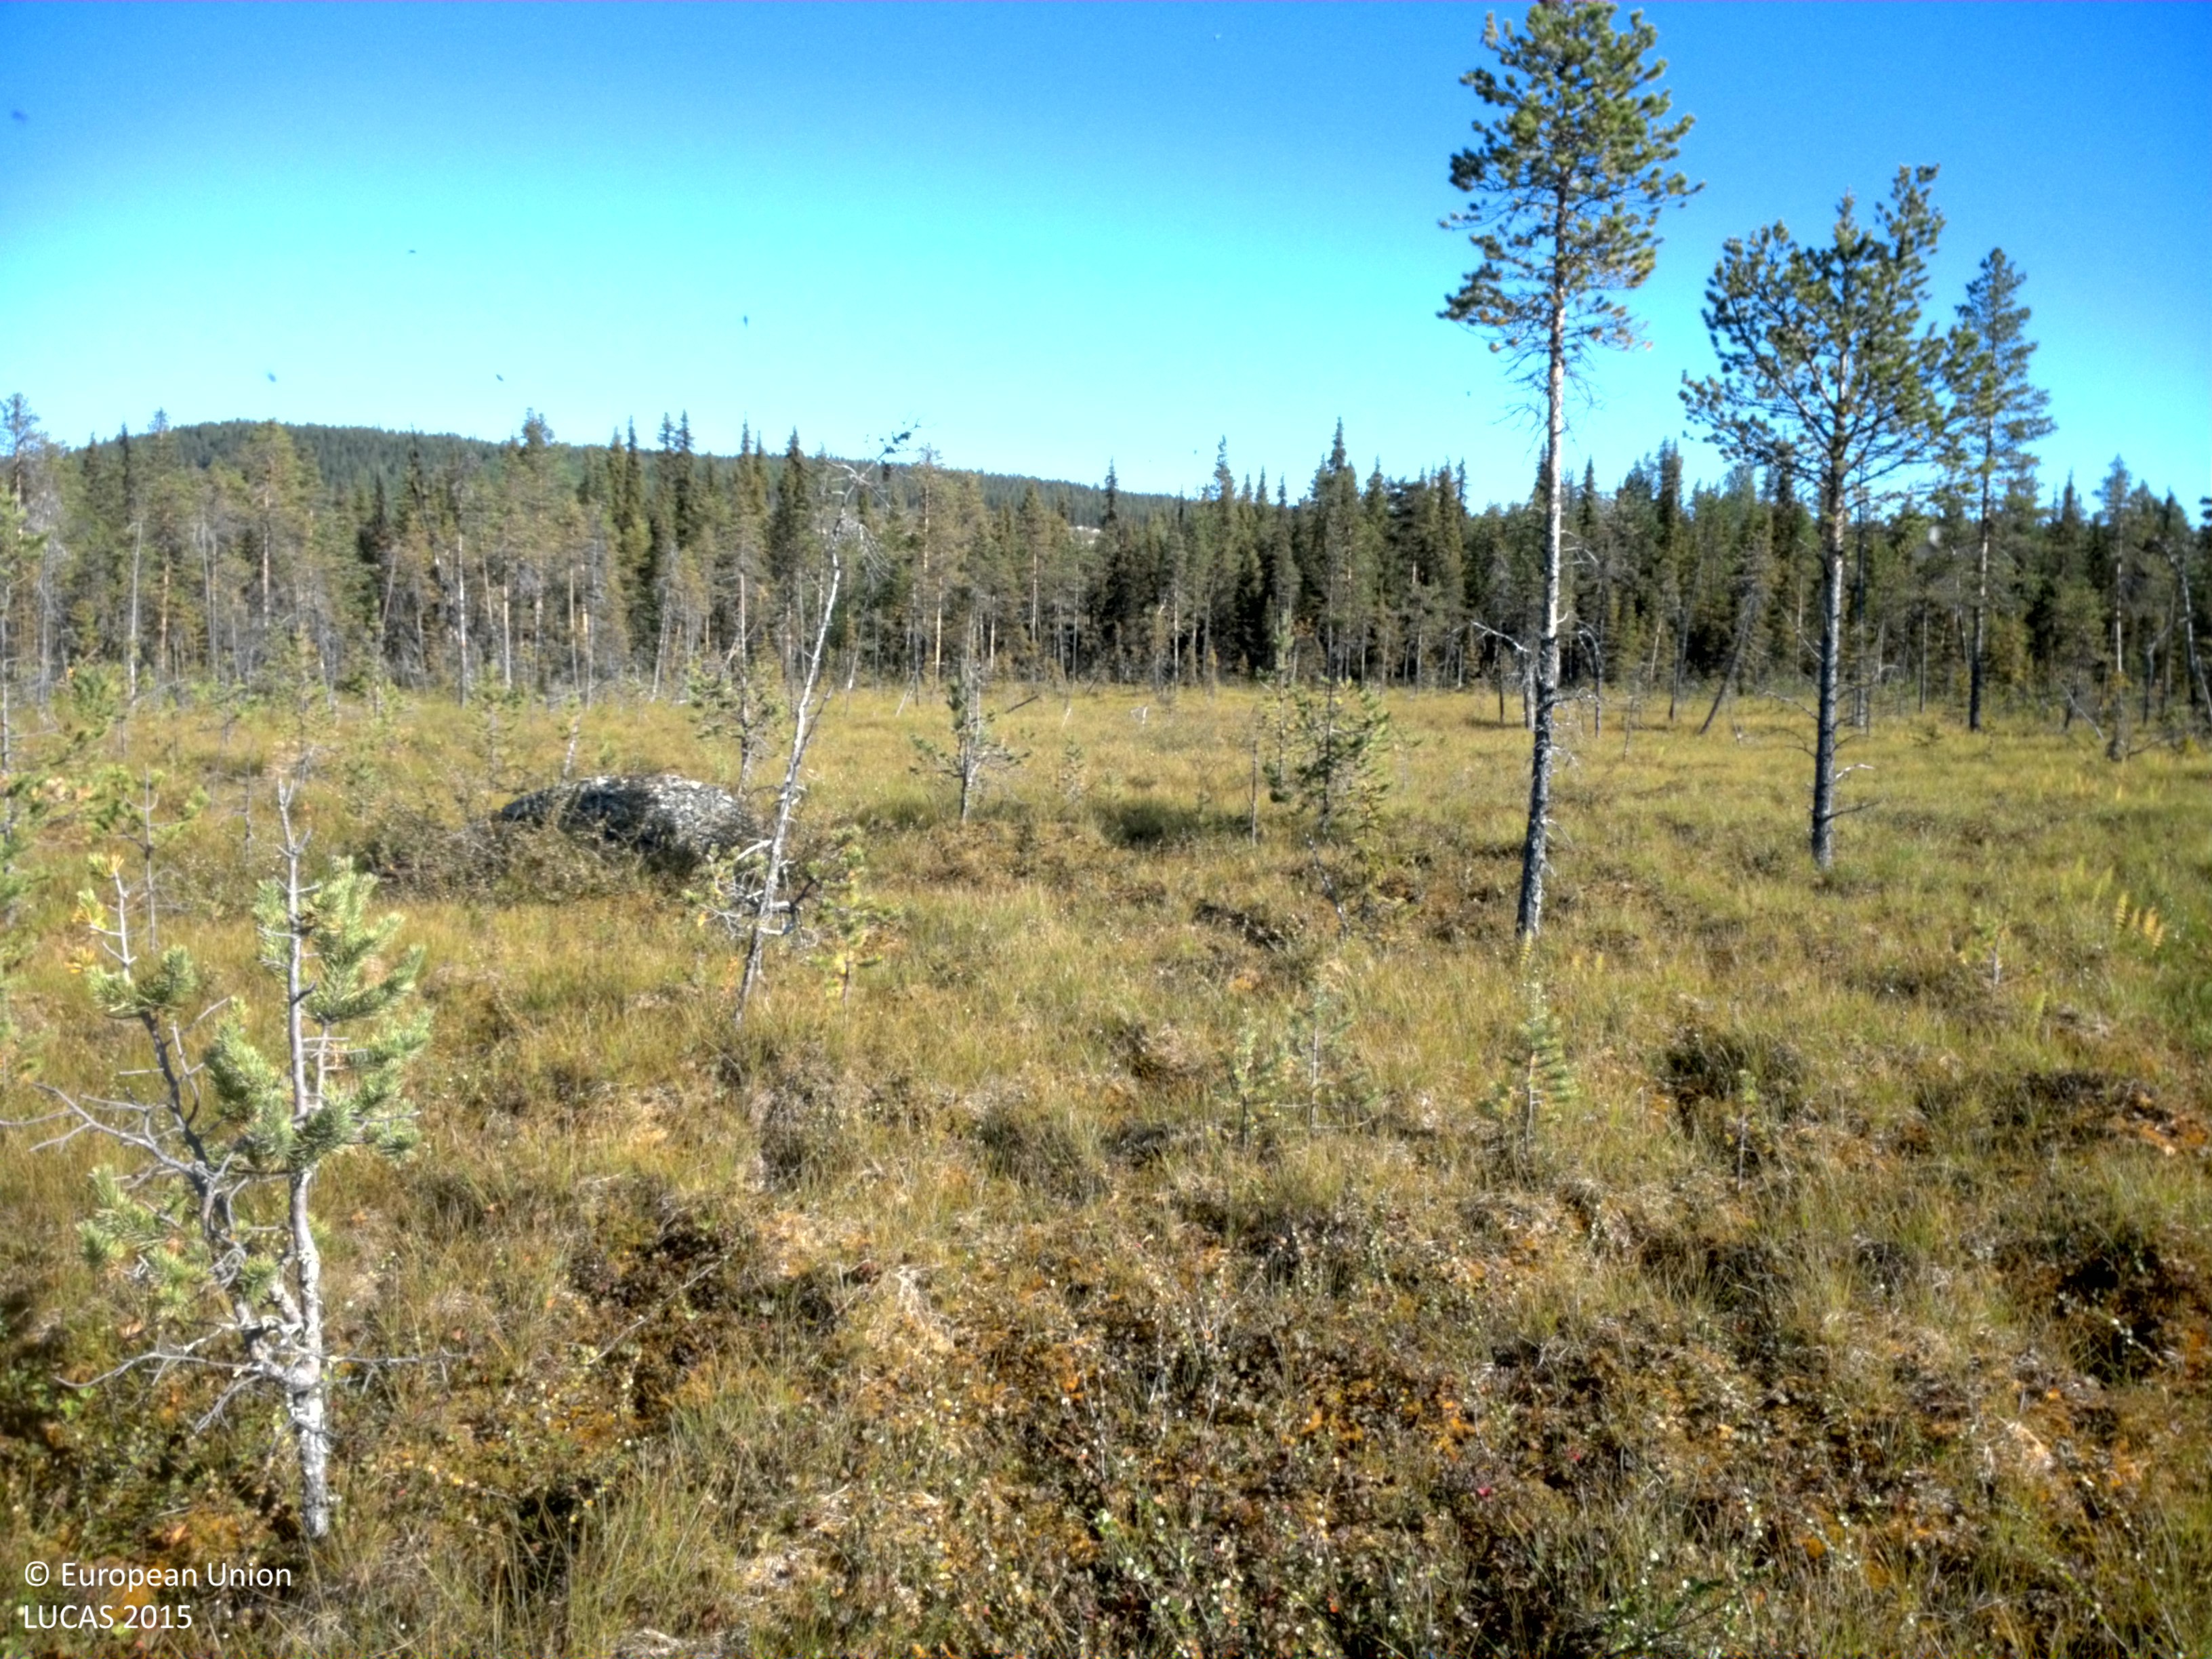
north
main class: Shrubland
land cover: Shrubland with sparse tree cover
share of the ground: 50 - 75 %
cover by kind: shrubs 60 %, herbaceous plants 35 %, coniferous forest trees 5 %
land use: Semi-natural and natural areas not in use
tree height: < 5 m
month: August
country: SE
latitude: 66.7410
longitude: 19.4584
